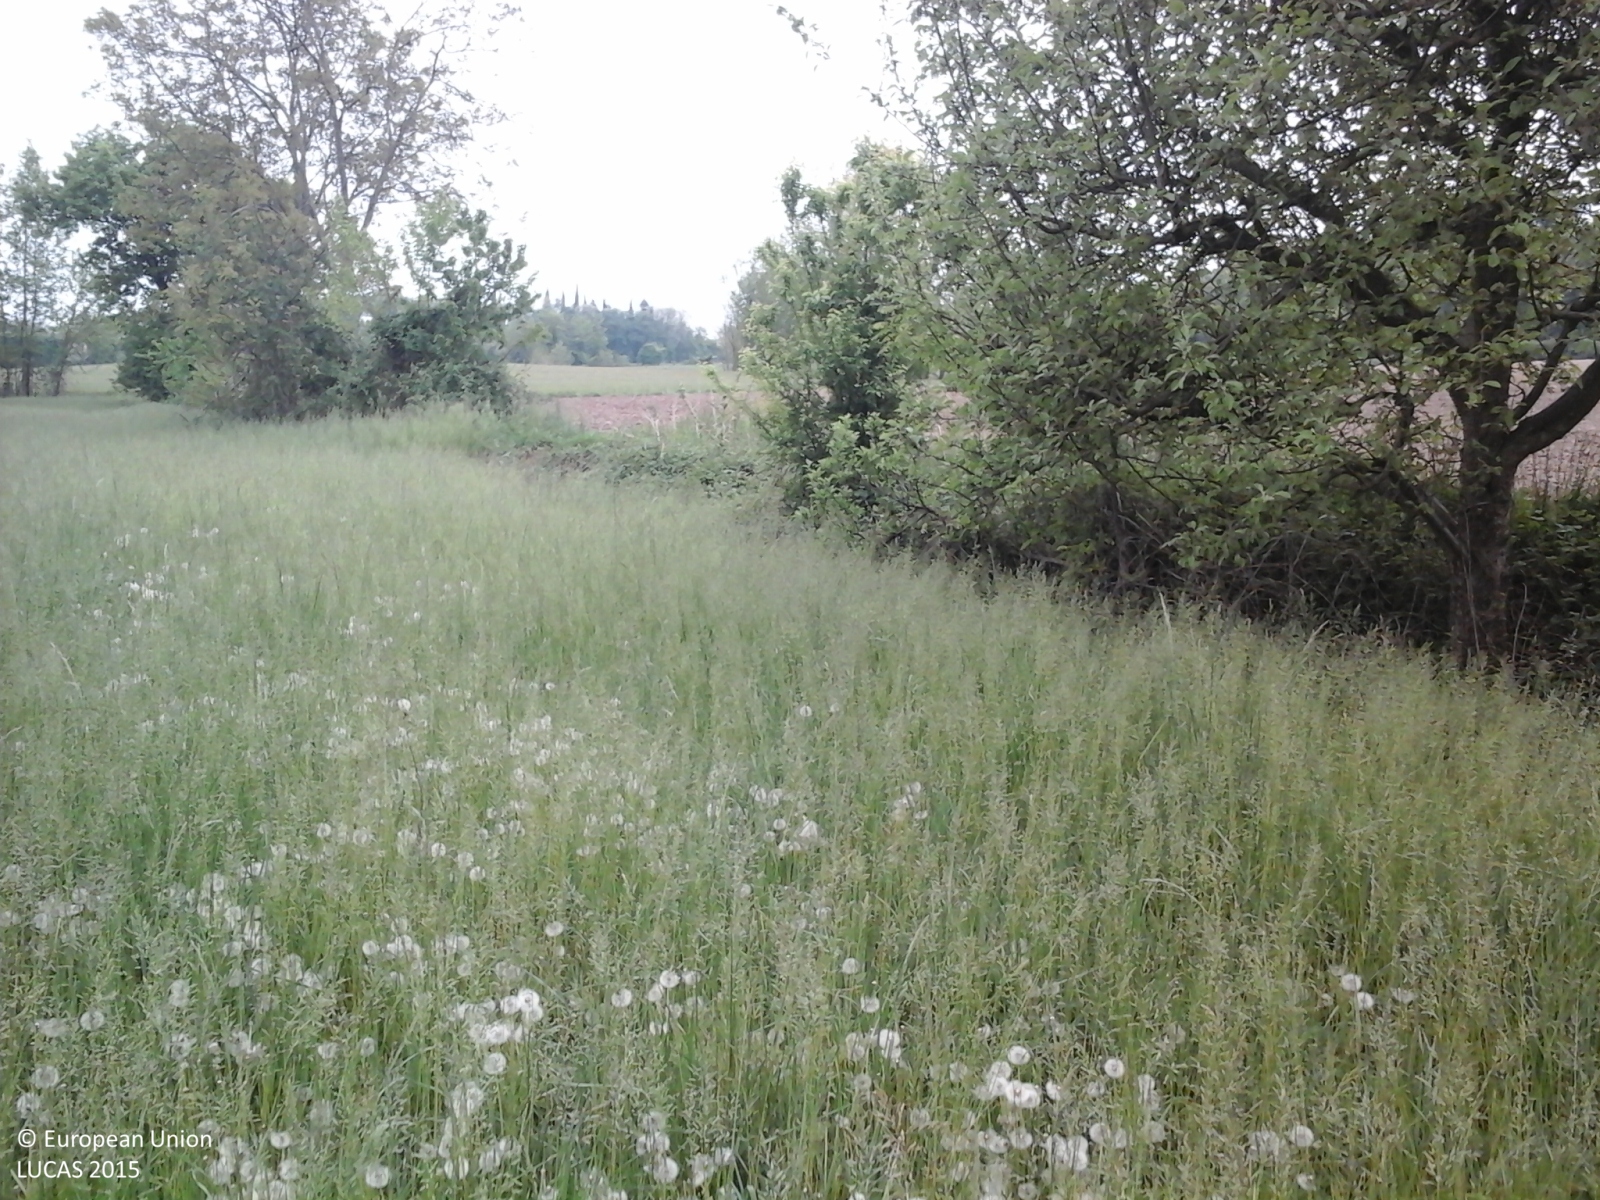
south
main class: Grassland
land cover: Spontaneously vegetated surfaces
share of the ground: > 75 %
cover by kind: herbaceous plants 100 %
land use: Agriculture (excluding fallow land and kitchen gardens)
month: April
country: IT
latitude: 45.4119
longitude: 10.7015
